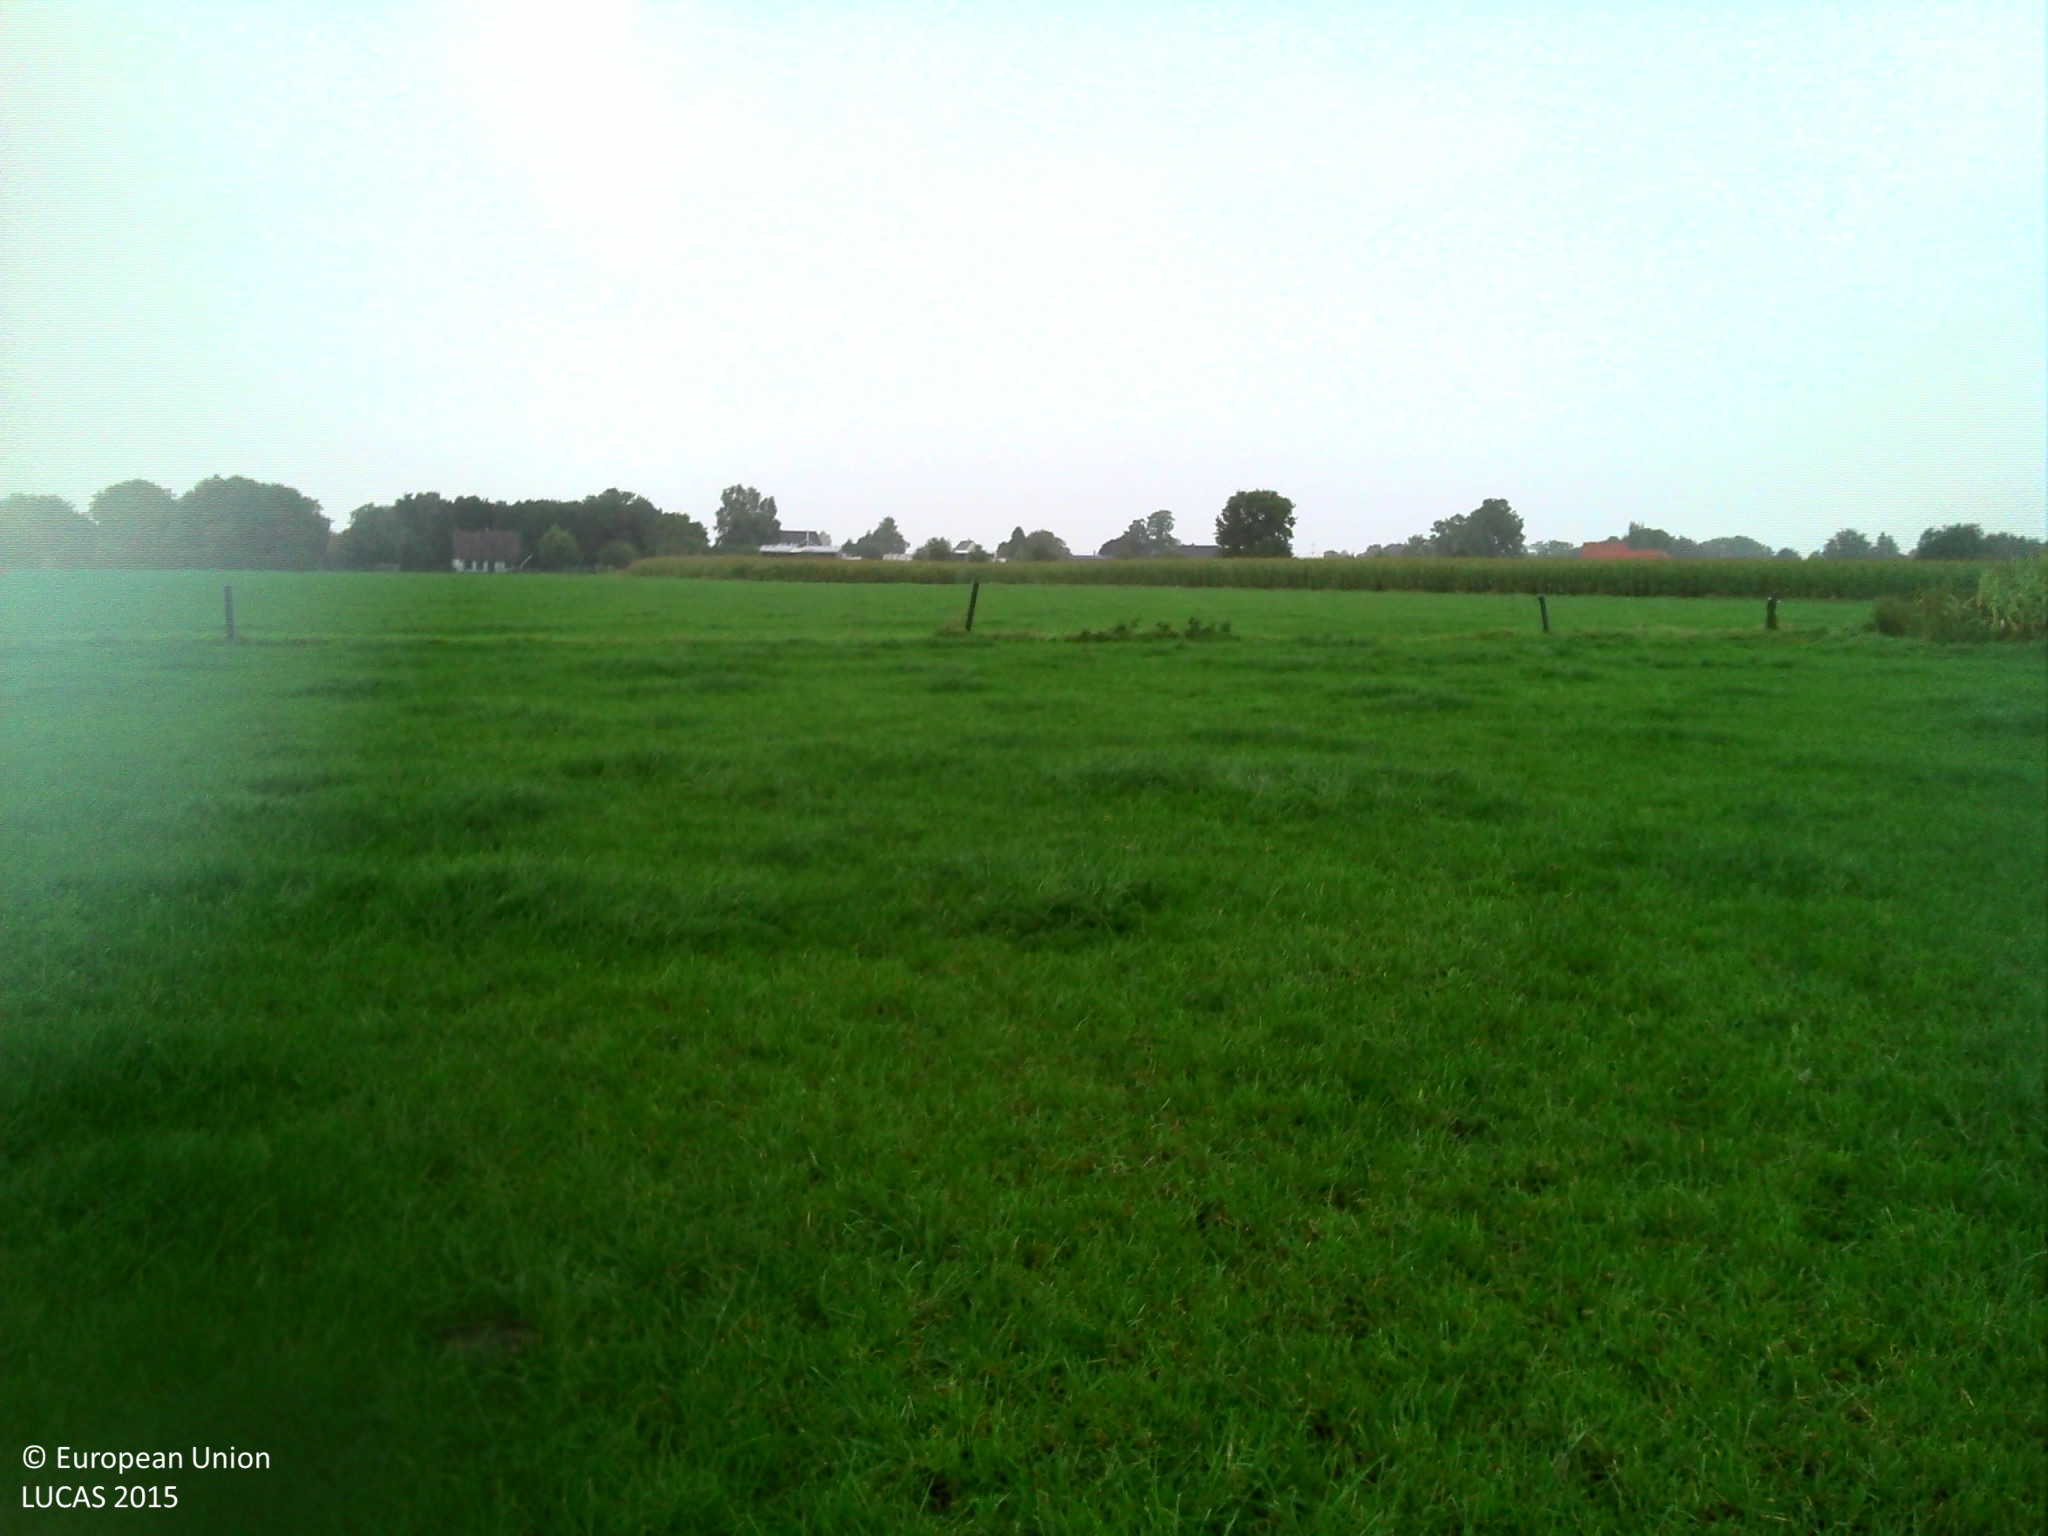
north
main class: Cropland
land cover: Temporary grasslands
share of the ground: > 75 %
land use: Agriculture (excluding fallow land and kitchen gardens)
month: September
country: BE
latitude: 51.3608
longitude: 4.7545
